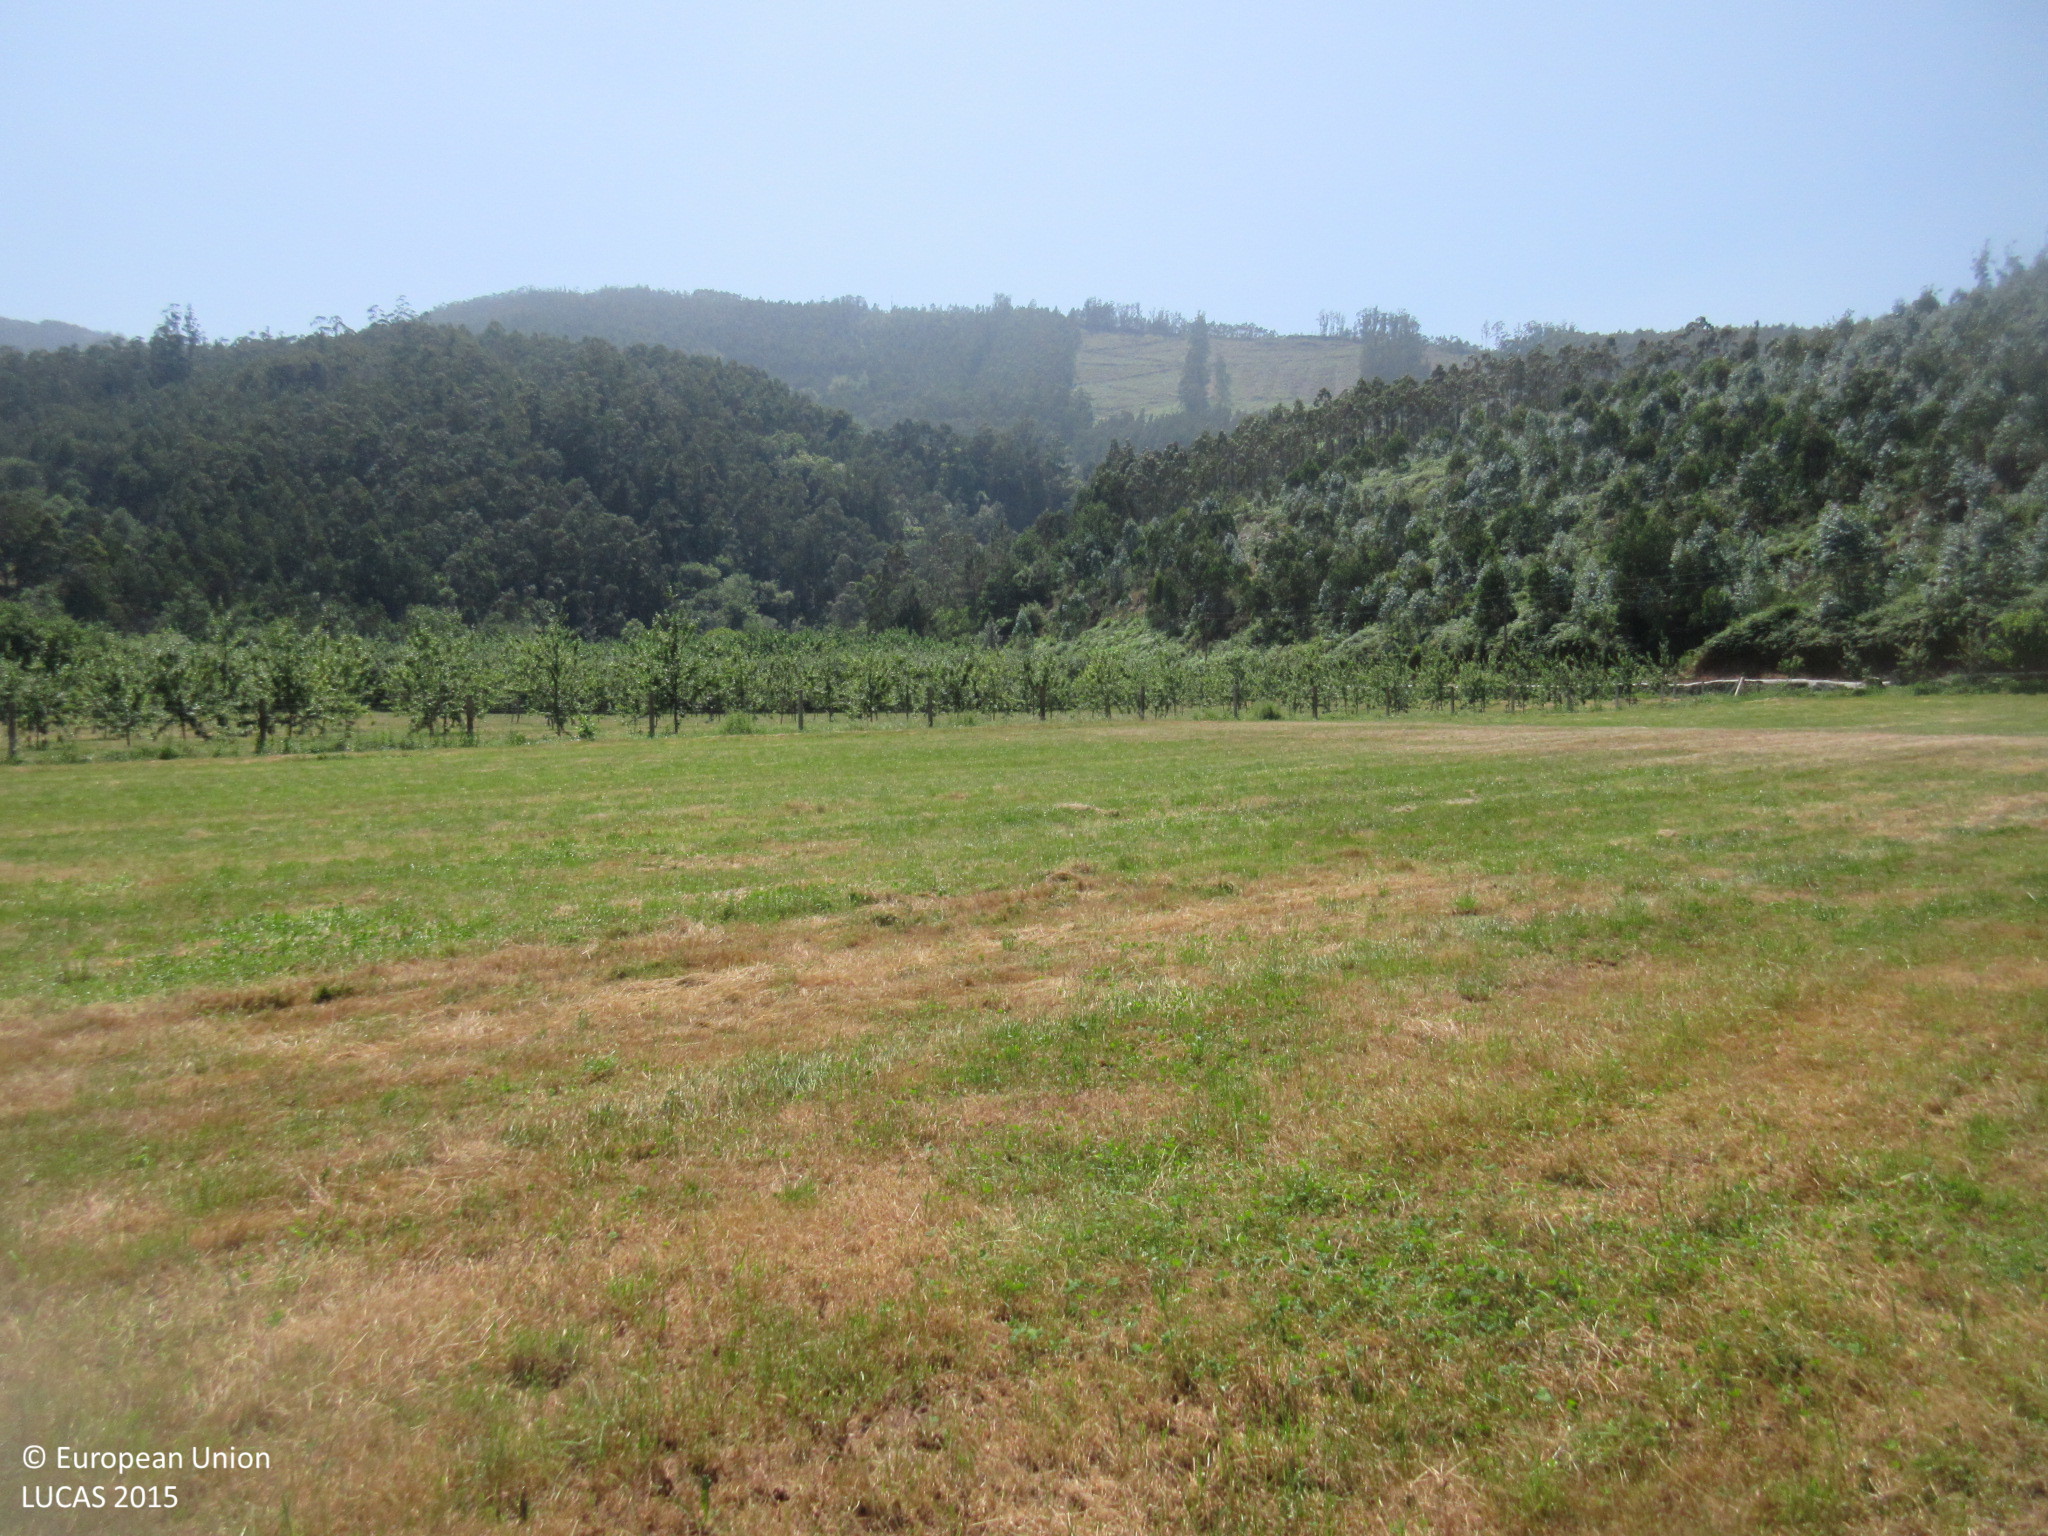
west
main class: Grassland
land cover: Grassland without tree/shrub cover
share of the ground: > 75 %
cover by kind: herbaceous plants 100 %
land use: Agriculture (excluding fallow land and kitchen gardens)
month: June
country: ES
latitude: 43.4069
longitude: -7.1488
